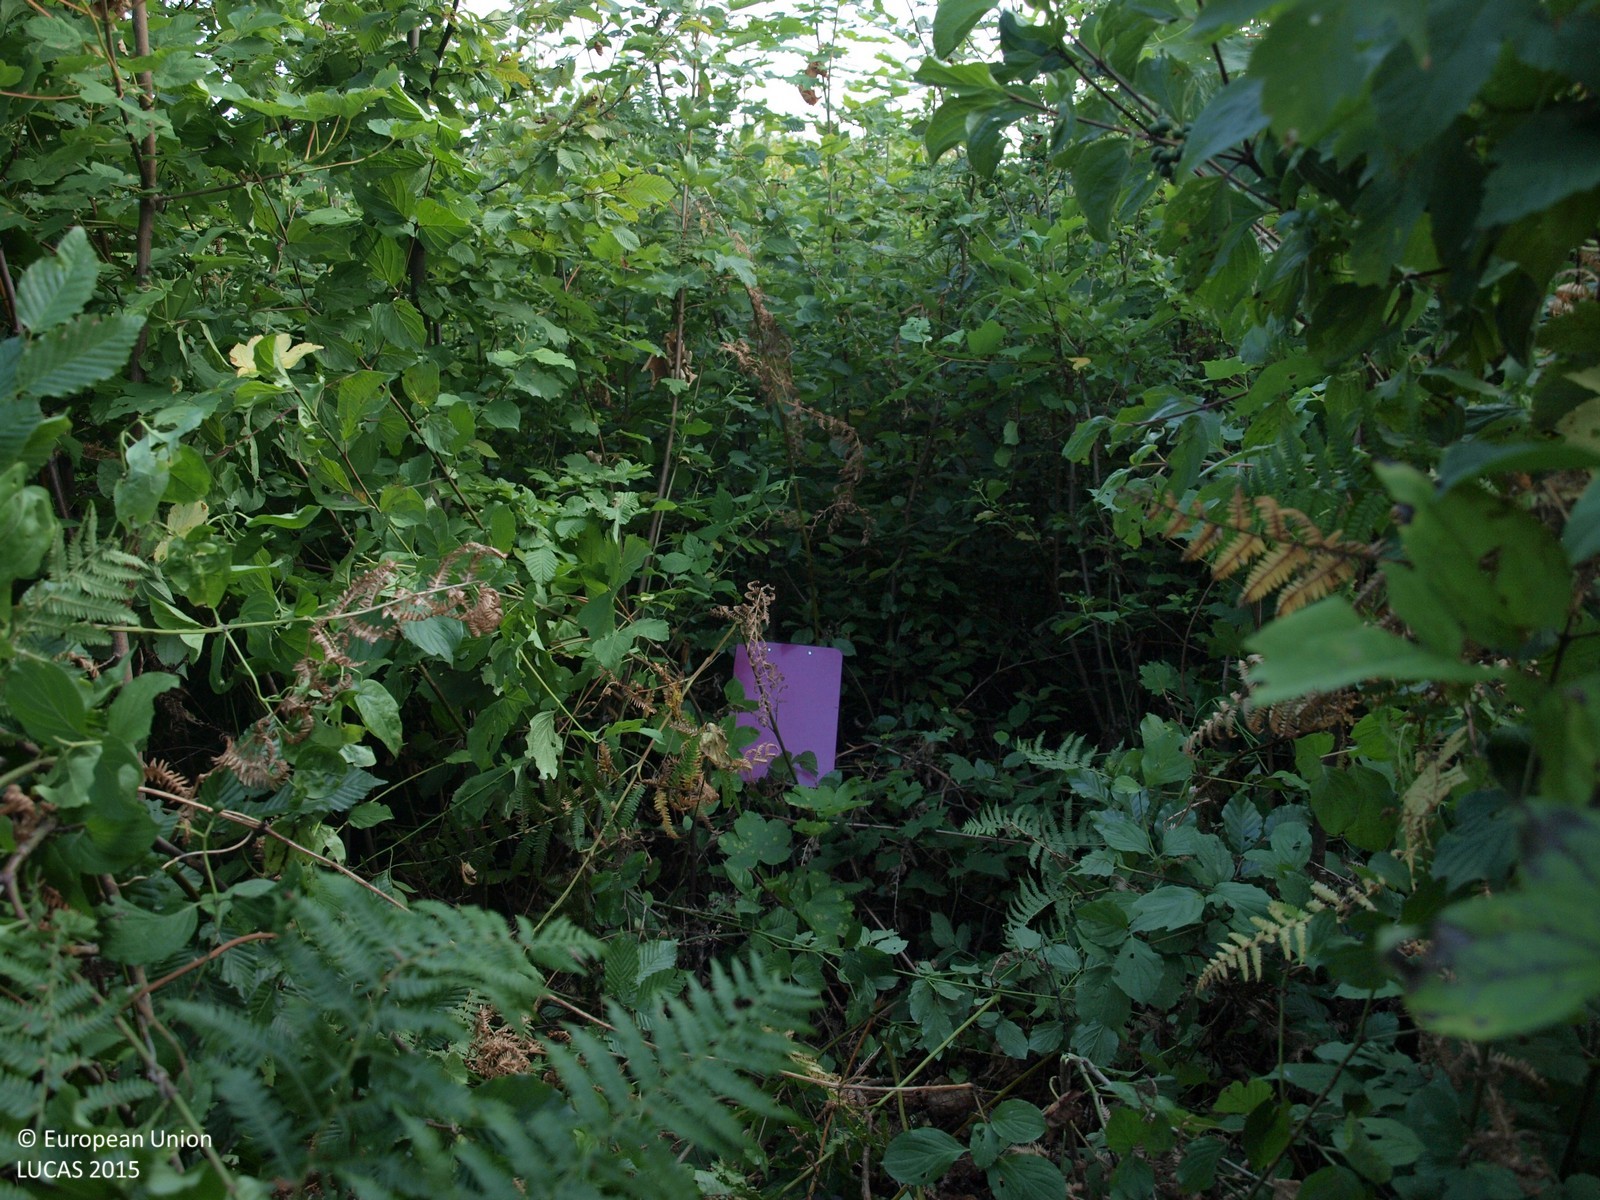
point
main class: Woodland
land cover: Broadleaved woodland
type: beech forest
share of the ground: > 75 %
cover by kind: broadleaved forest trees 100 %
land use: Forestry
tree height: < 5 m
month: August
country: HR
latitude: 45.9902
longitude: 16.2087
